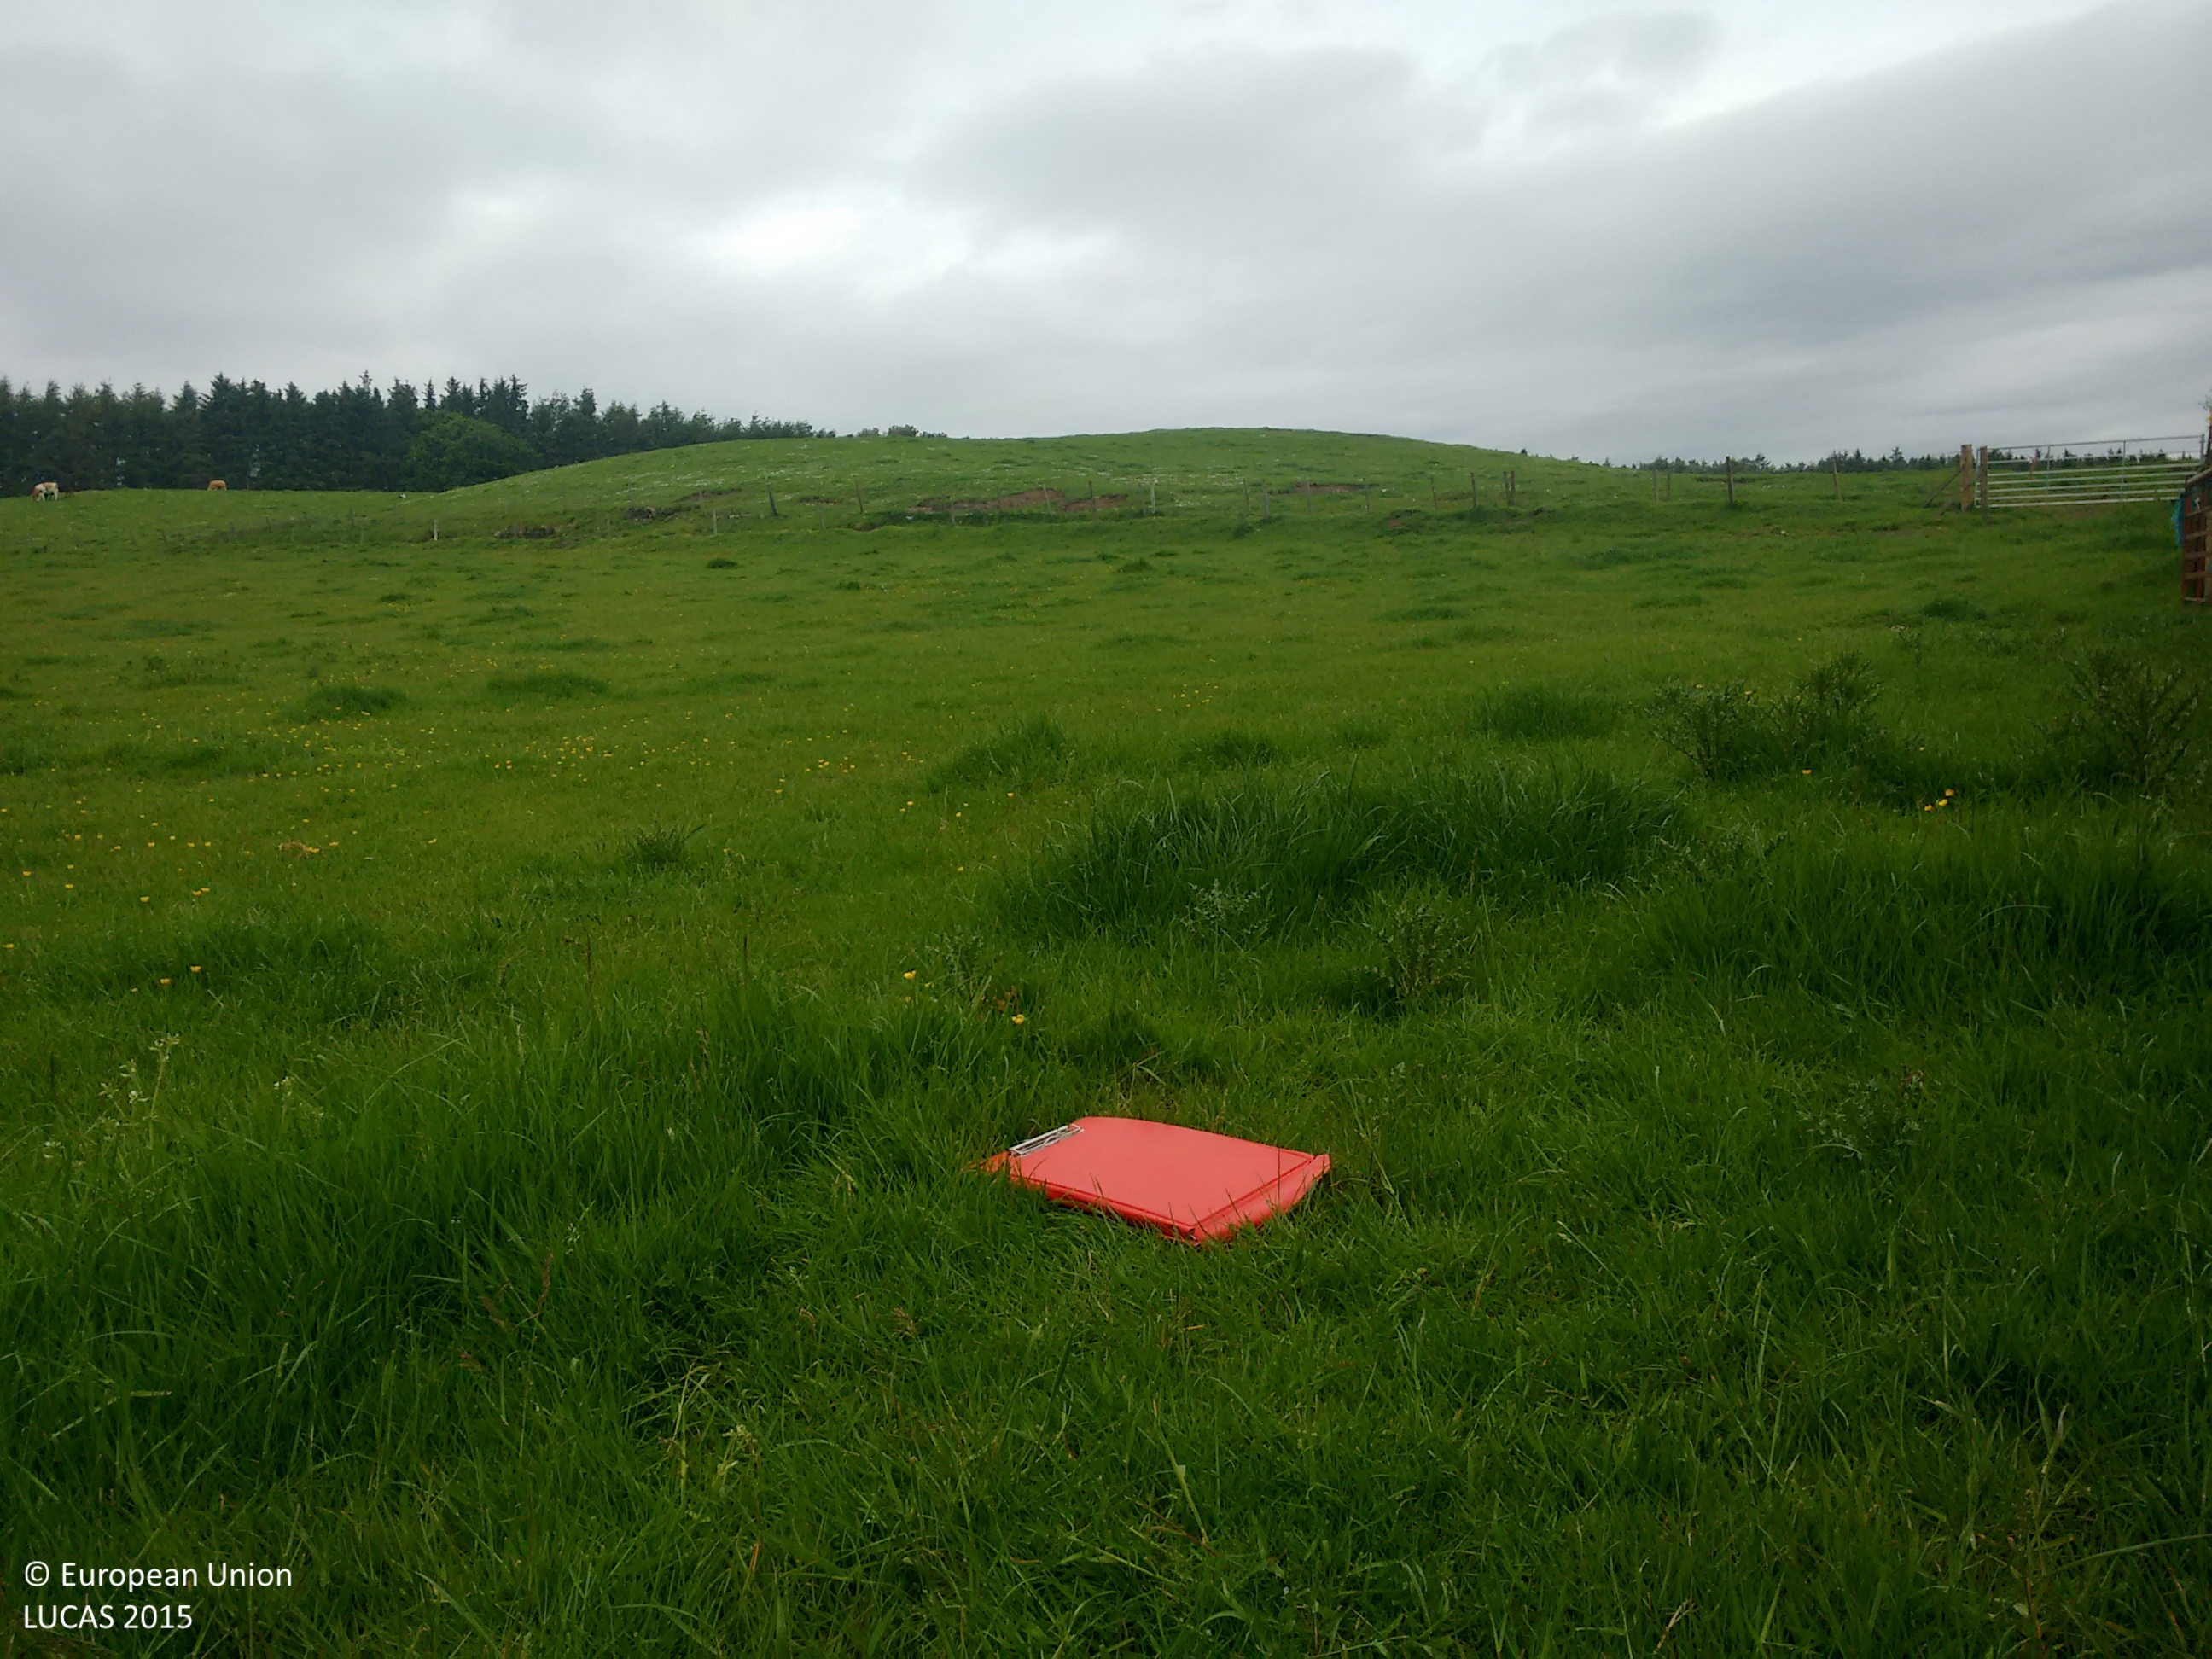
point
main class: Grassland
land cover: Grassland without tree/shrub cover
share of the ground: > 75 %
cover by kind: herbaceous plants 100 %
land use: Agriculture (excluding fallow land and kitchen gardens)
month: June
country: GB
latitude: 55.6978
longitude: -3.5882
